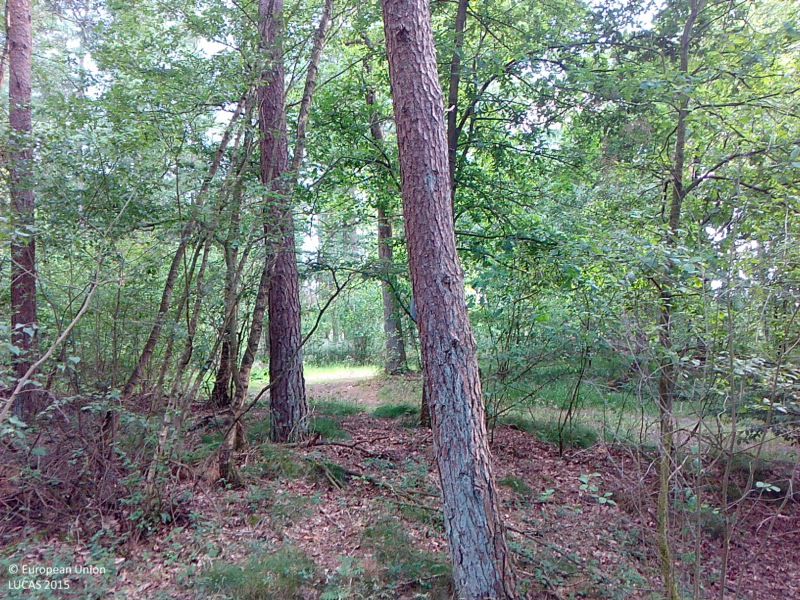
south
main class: Woodland
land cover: Pine dominated mixed woodland
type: hemiboreal forest and nemoral coniferous forest and mixed broadleaved-coniferous forest
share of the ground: > 75 %
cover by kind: coniferous forest trees 40 %, broadleaved forest trees 35 %, shrubs 15 %, herbaceous plants 10 %
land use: Forestry
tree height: > 5 m
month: June
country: DE
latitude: 52.4940
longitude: 7.4523
